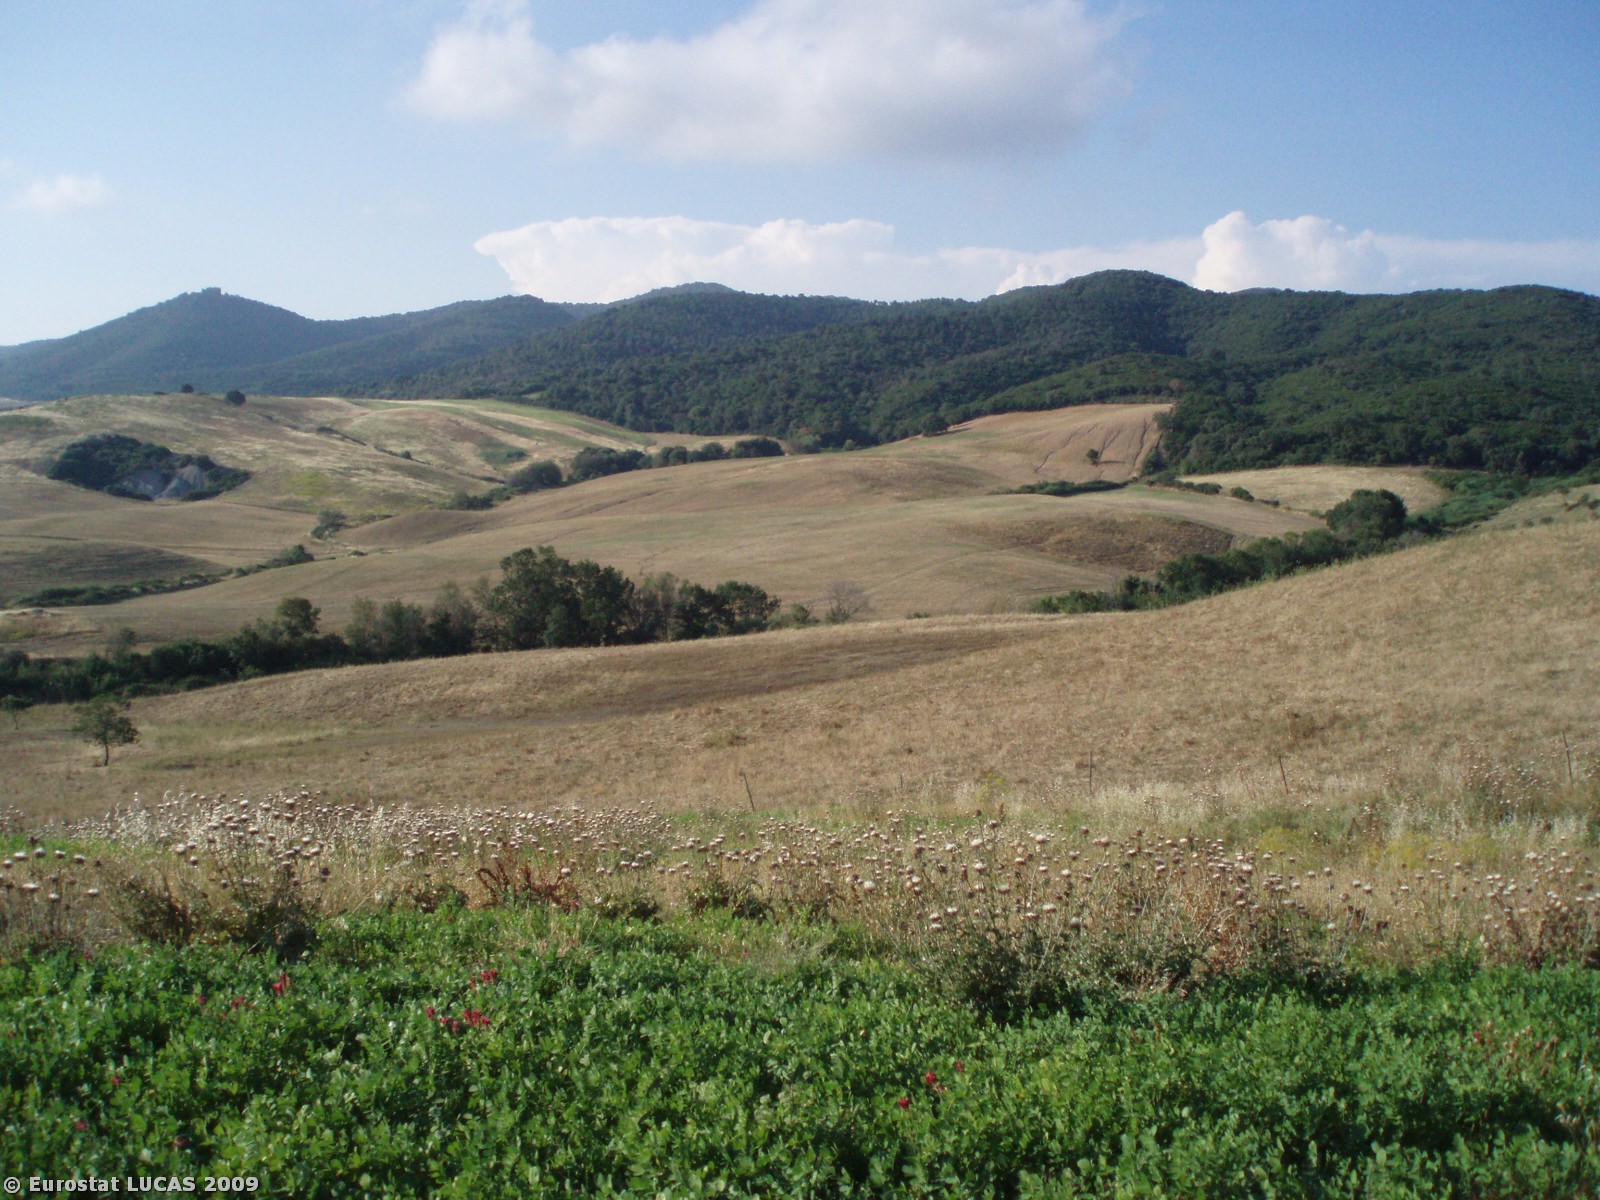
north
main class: Woodland
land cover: Broadleaved woodland
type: thermophilous deciduous forest
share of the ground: > 75 %
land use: Forestry
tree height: > 5 m
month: June
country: IT
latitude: 42.4790
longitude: 11.5881
